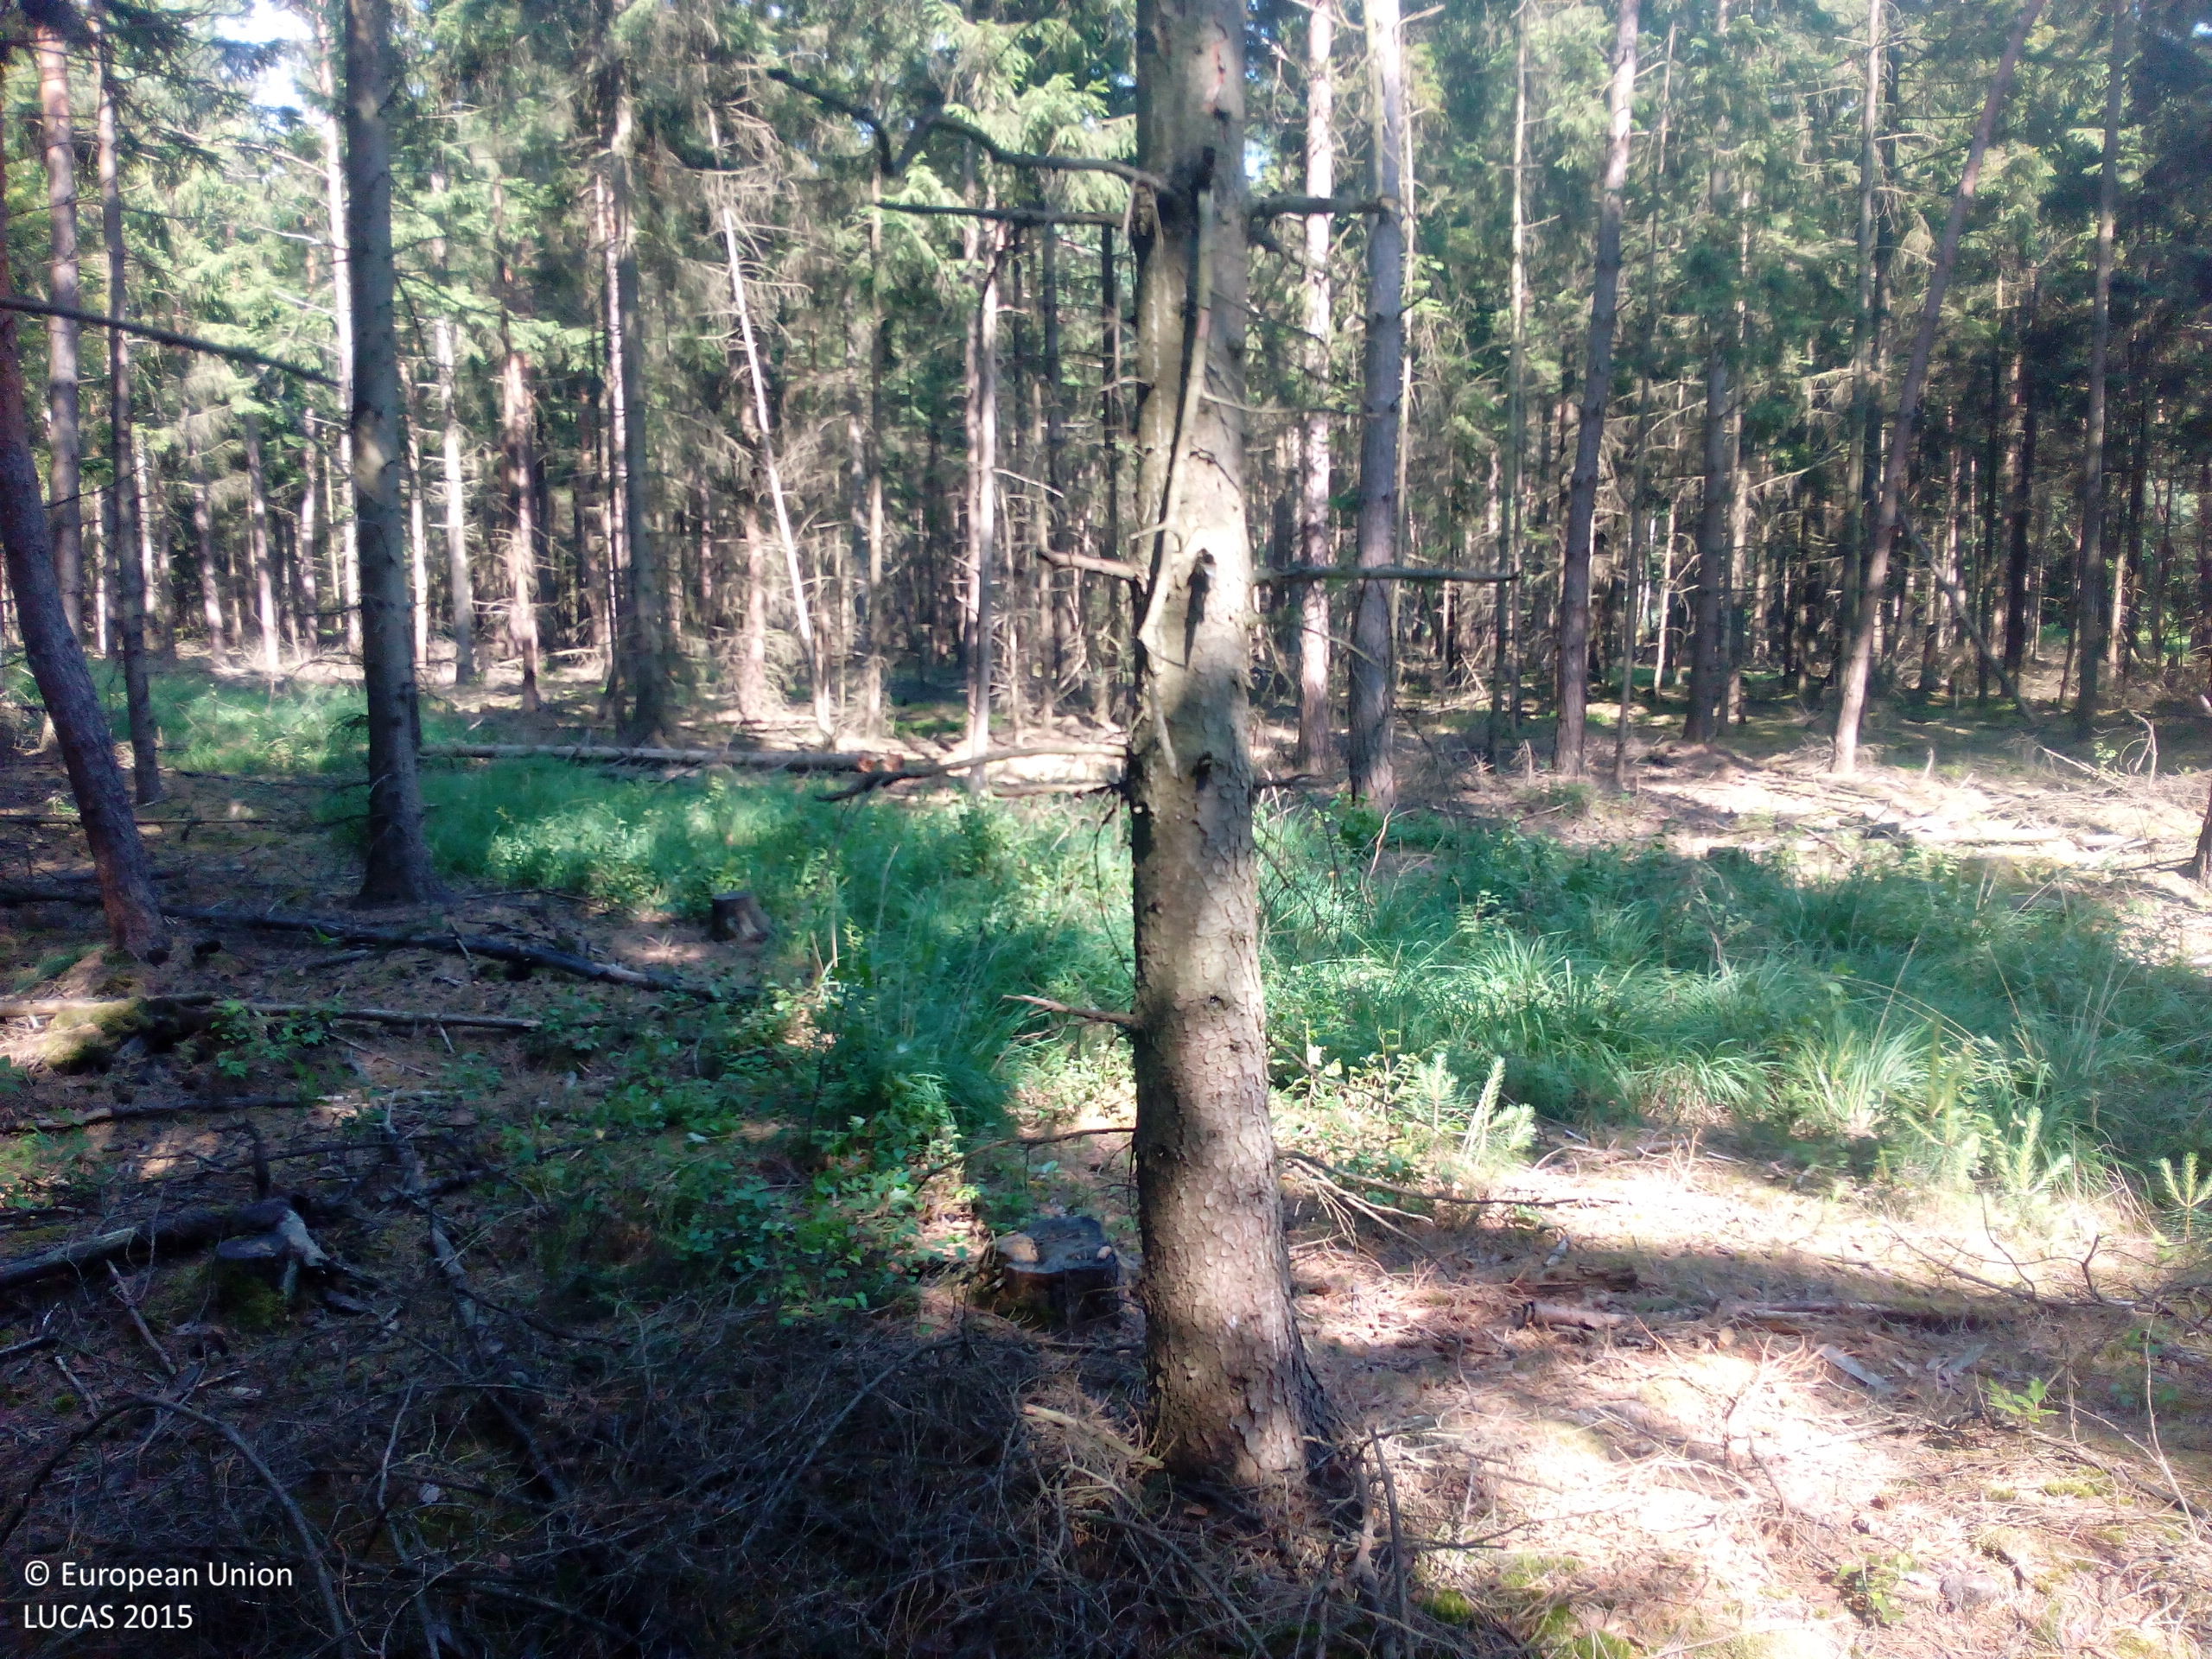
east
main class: Woodland
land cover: Spruce dominated coniferous woodland
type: hemiboreal forest and nemoral coniferous forest and mixed broadleaved-coniferous forest
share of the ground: > 75 %
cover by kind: coniferous forest trees 80 %, shrubs 10 %, herbaceous plants 10 %
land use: Forestry
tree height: > 5 m
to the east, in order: Spruce dominated coniferous woodland; Ditches and canals; Broadleaved woodland
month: July
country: DE
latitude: 52.6813
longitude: 10.6358
